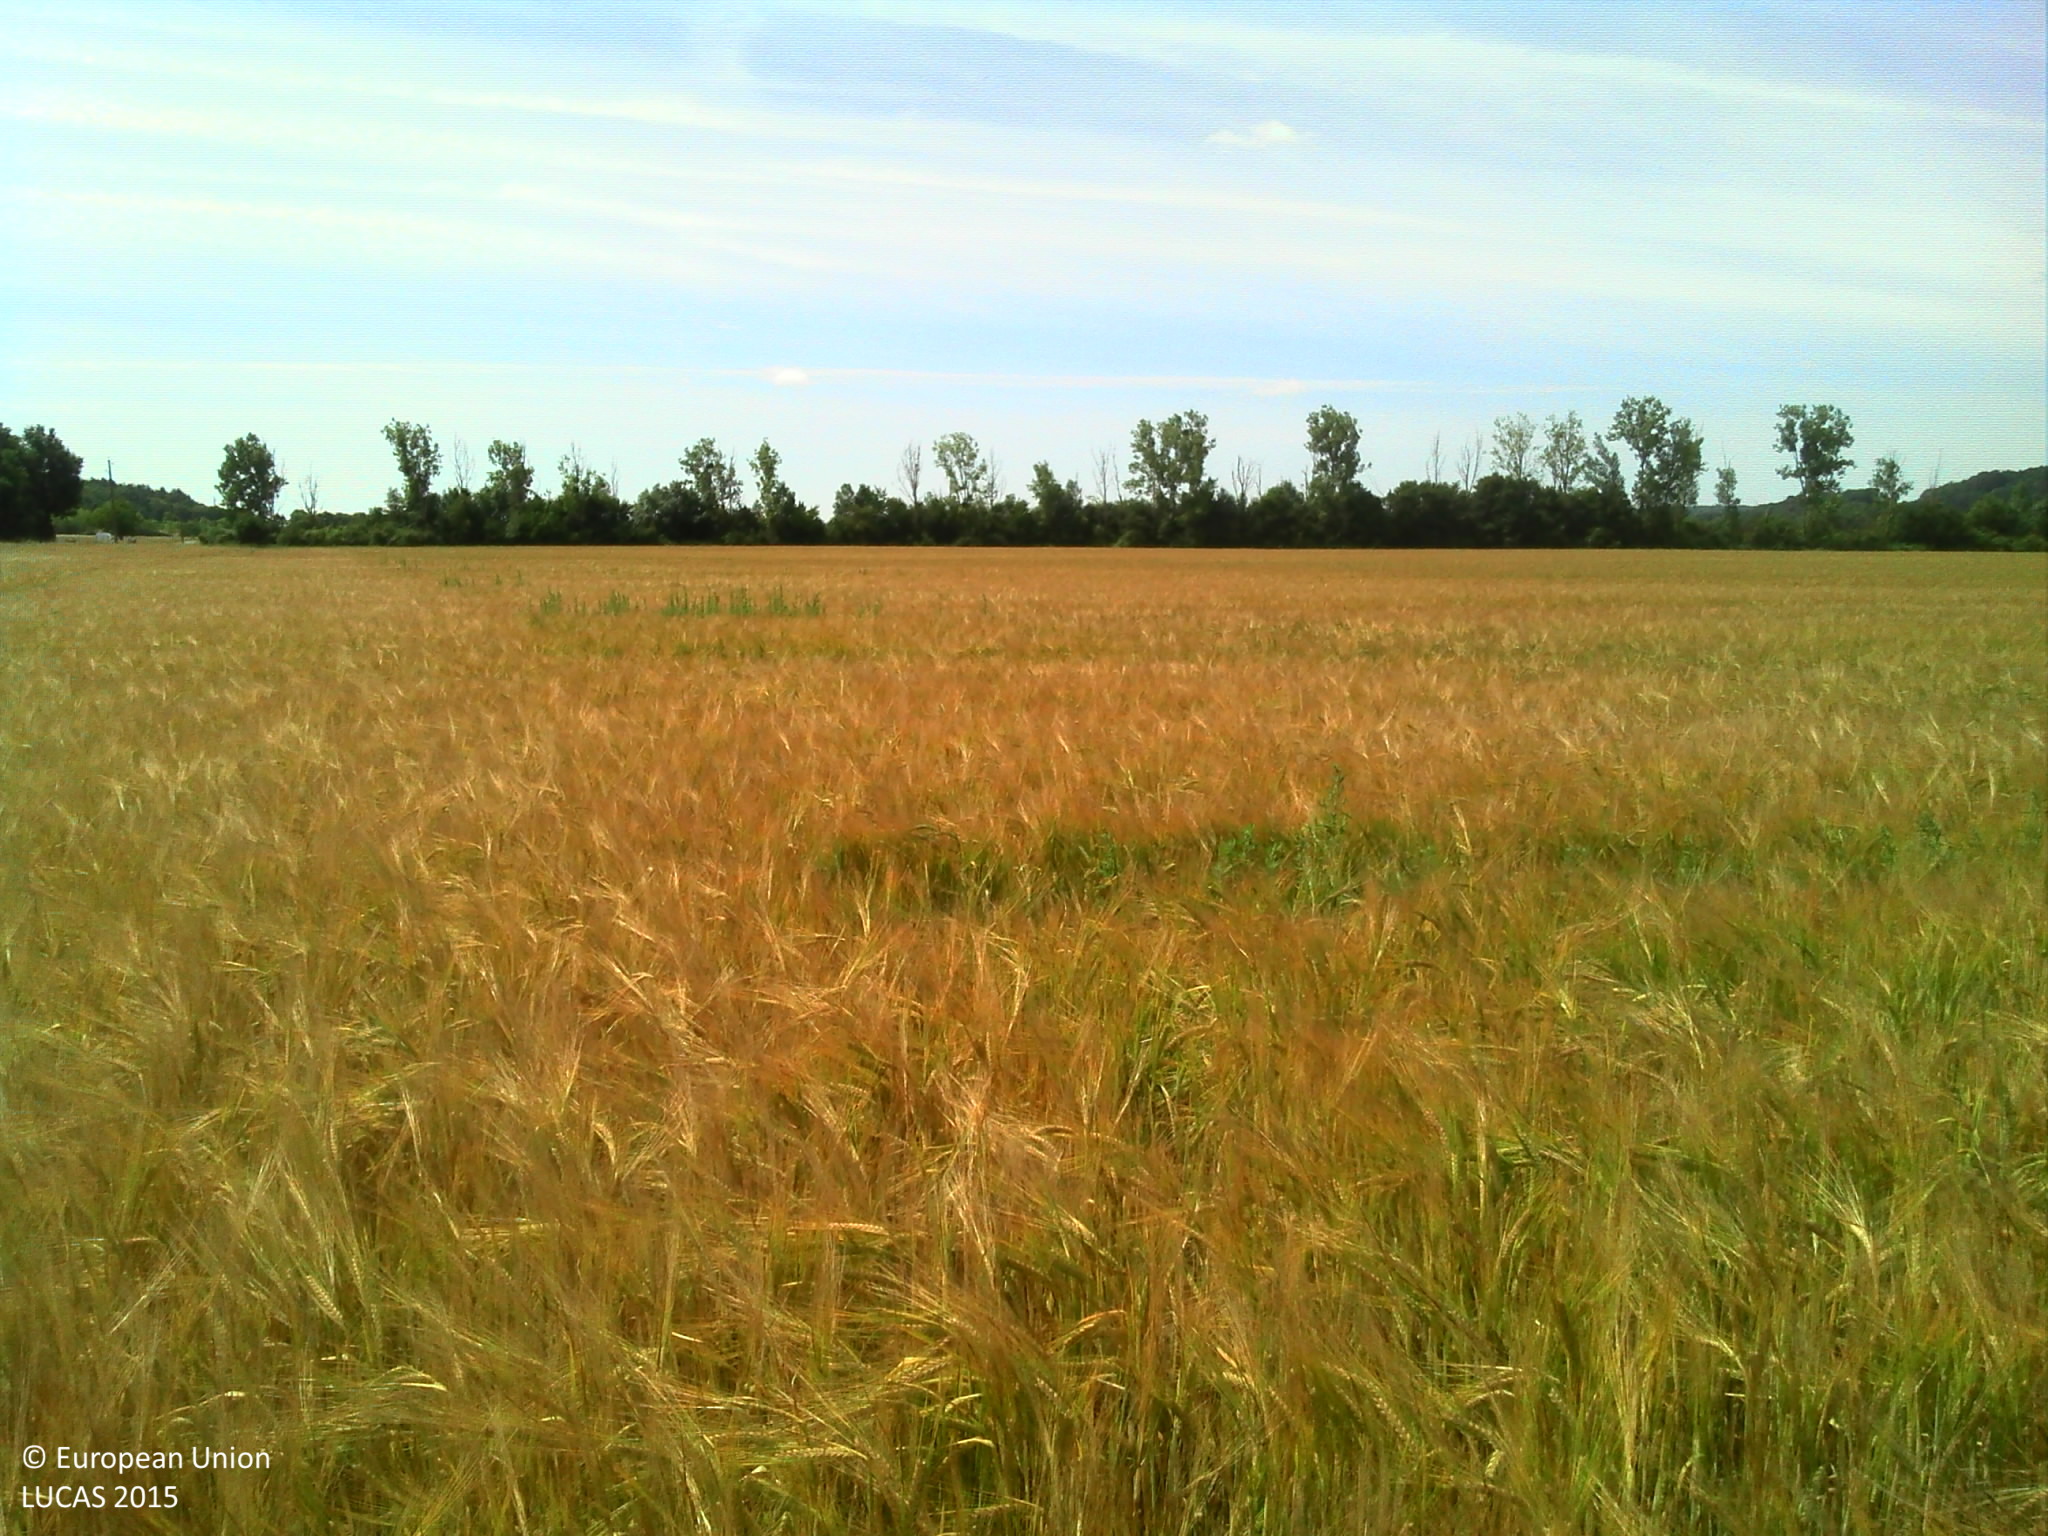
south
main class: Cropland
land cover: Barley
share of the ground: > 75 %
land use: Agriculture (excluding fallow land and kitchen gardens)
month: June
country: FR
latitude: 46.8256
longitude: 0.8208
